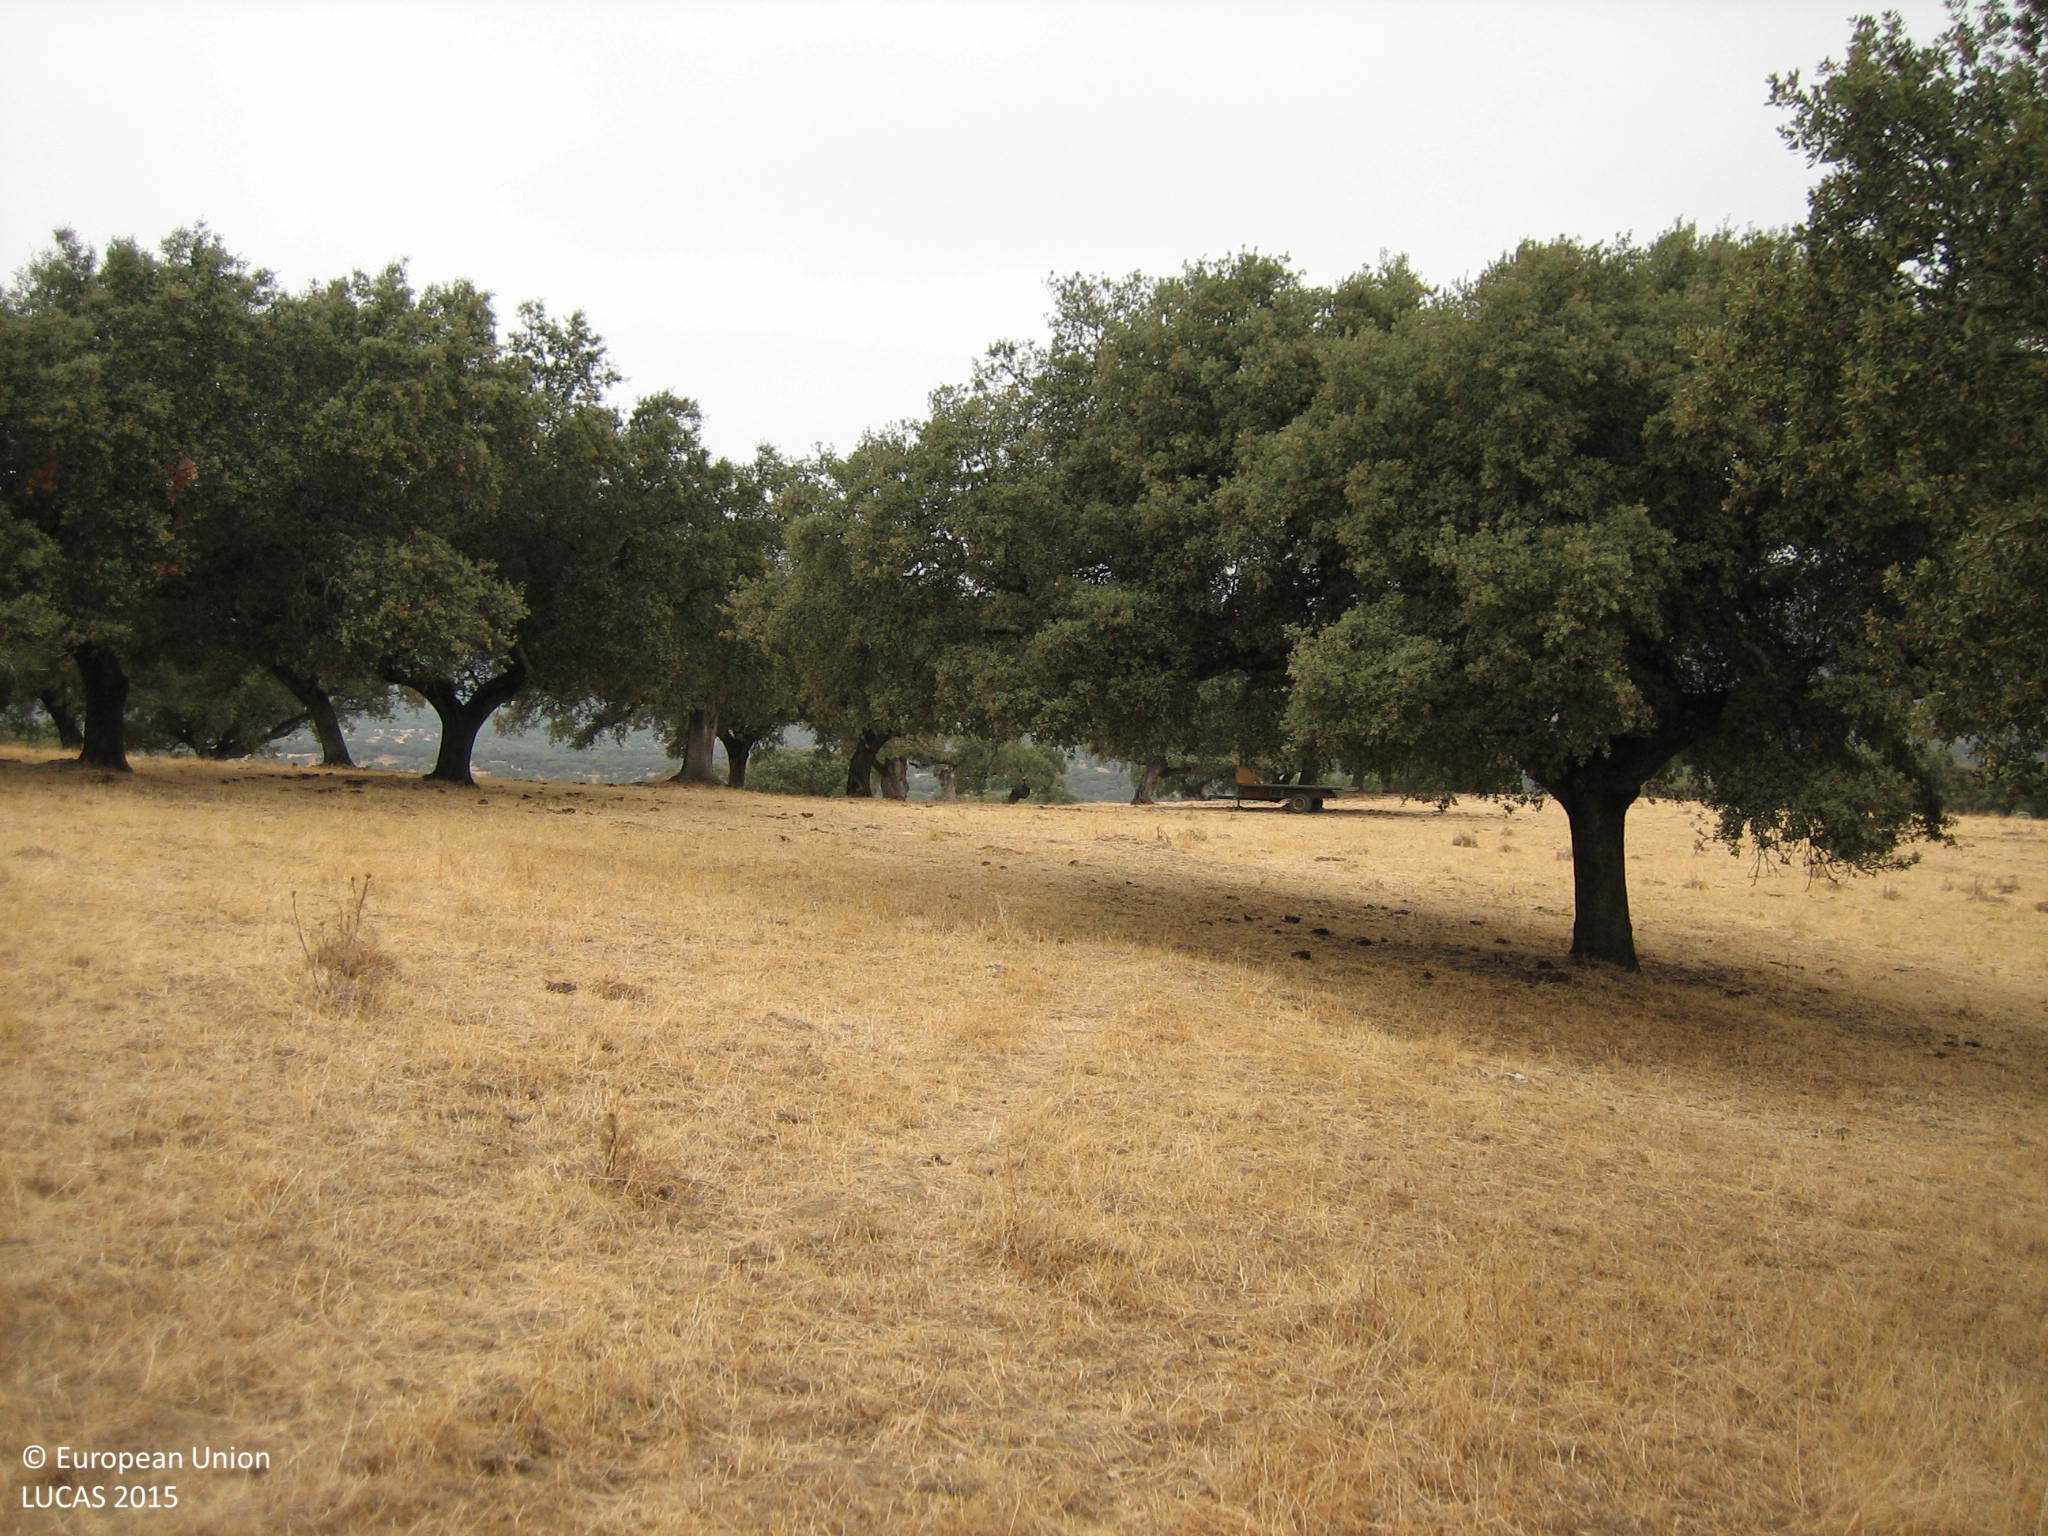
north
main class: Woodland
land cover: Broadleaved woodland
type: broadleaved evergreen forest
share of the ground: 25 - 50 %
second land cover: Grassland without tree/shrub cover
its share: > 75 %
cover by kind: herbaceous plants 60 %, broadleaved forest trees 40 %
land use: Forestry
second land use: Agriculture (excluding fallow land and kitchen gardens)
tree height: > 5 m
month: September
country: ES
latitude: 38.3033
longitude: -6.8319
